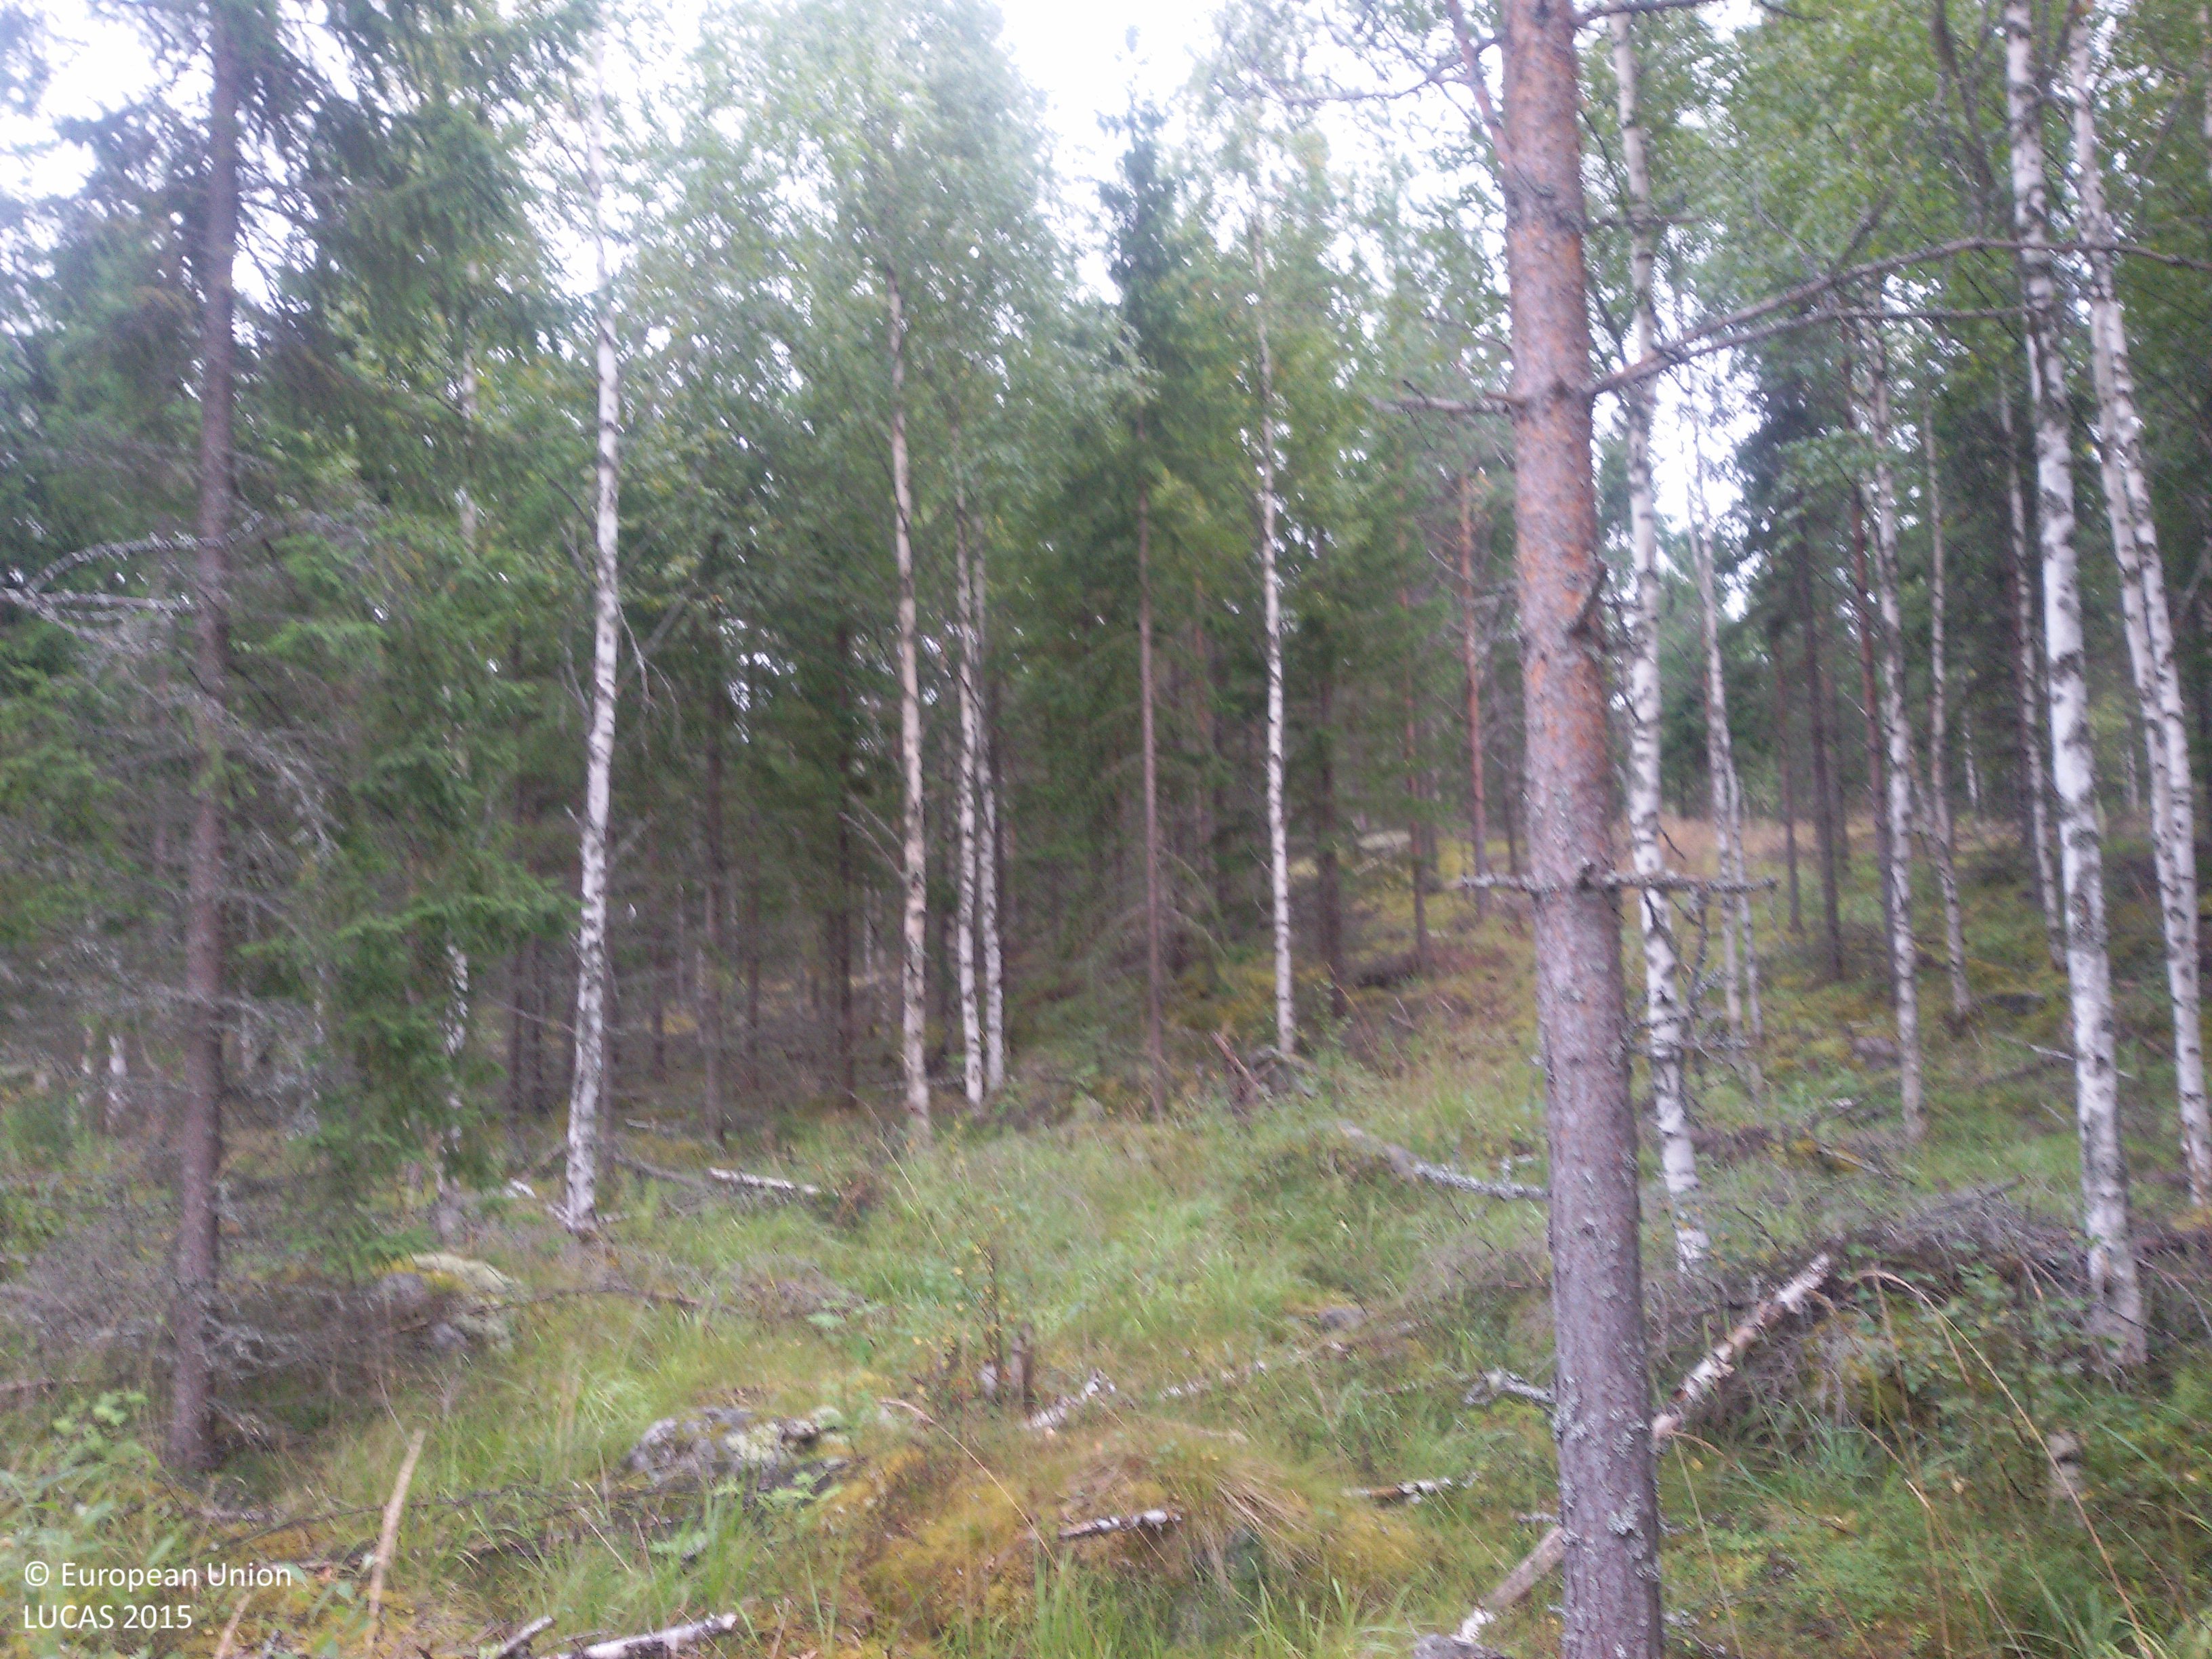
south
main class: Woodland
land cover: Spruce dominated mixed woodland
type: boreal forest
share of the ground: 50 - 75 %
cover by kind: coniferous forest trees 35 %, broadleaved forest trees 35 %, herbaceous plants 20 %, lichens and mosses 10 %
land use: Forestry
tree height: > 5 m
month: September
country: SE
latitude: 60.8193
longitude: 15.8151
